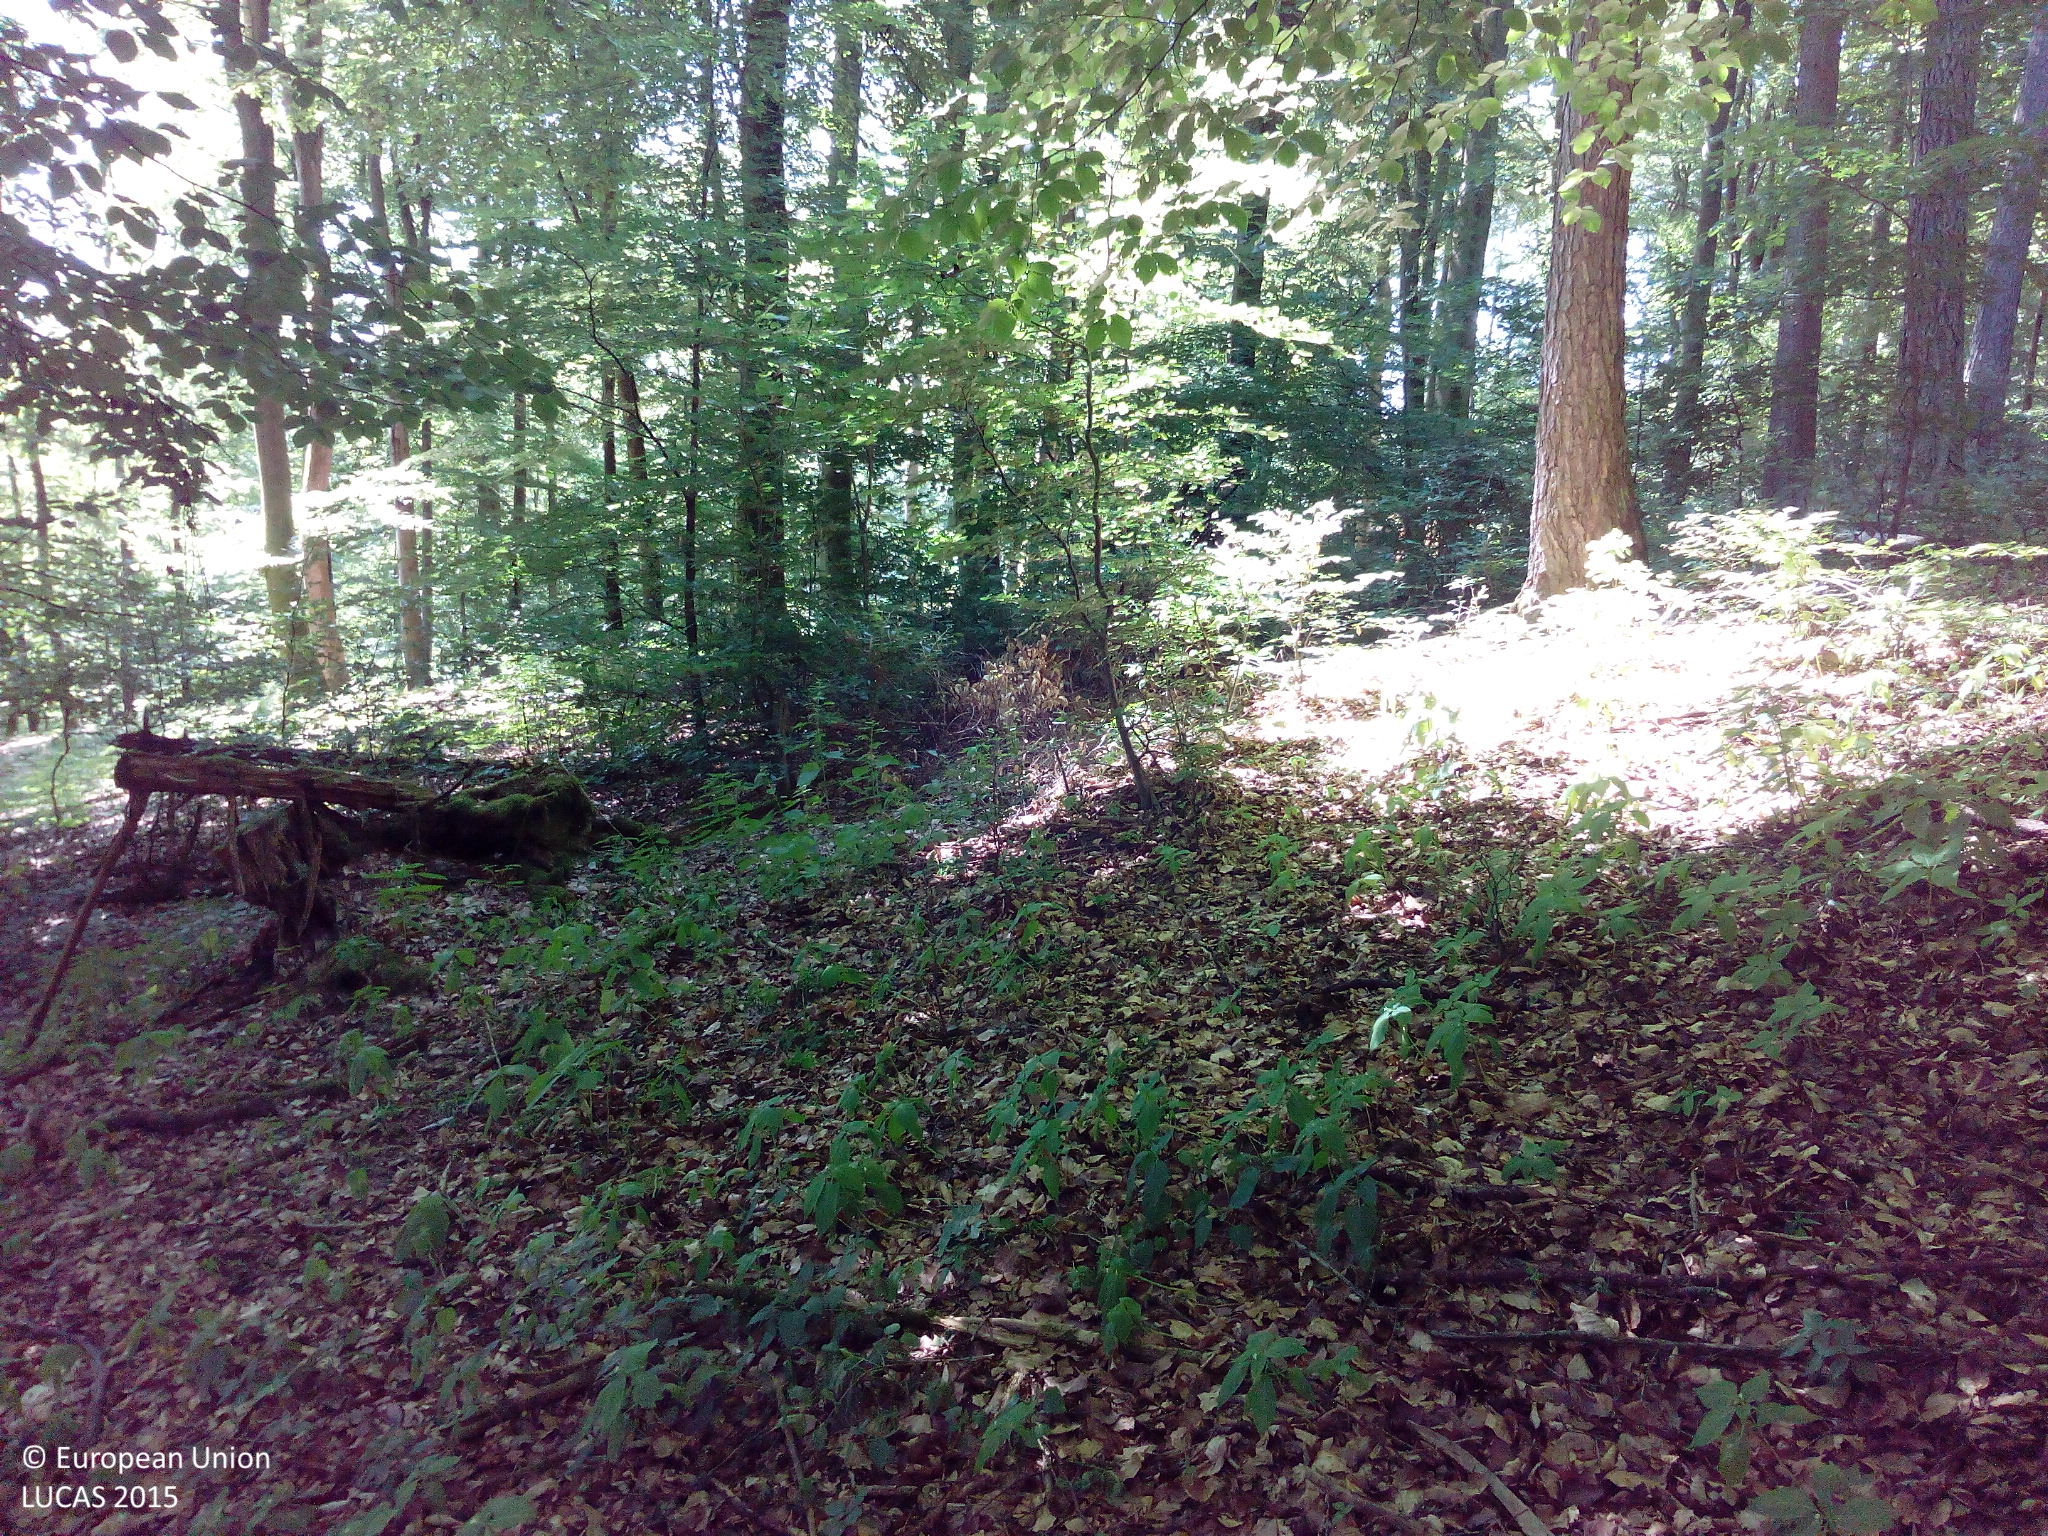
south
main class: Woodland
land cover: Spruce dominated mixed woodland
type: mesophytic deciduous forest
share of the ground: > 75 %
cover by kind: broadleaved forest trees 55 %, coniferous forest trees 30 %, herbaceous plants 10 %, unconsolidated bare surface 5 %
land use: Forestry
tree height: > 5 m
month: July
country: DE
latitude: 50.1133
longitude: 8.0286
